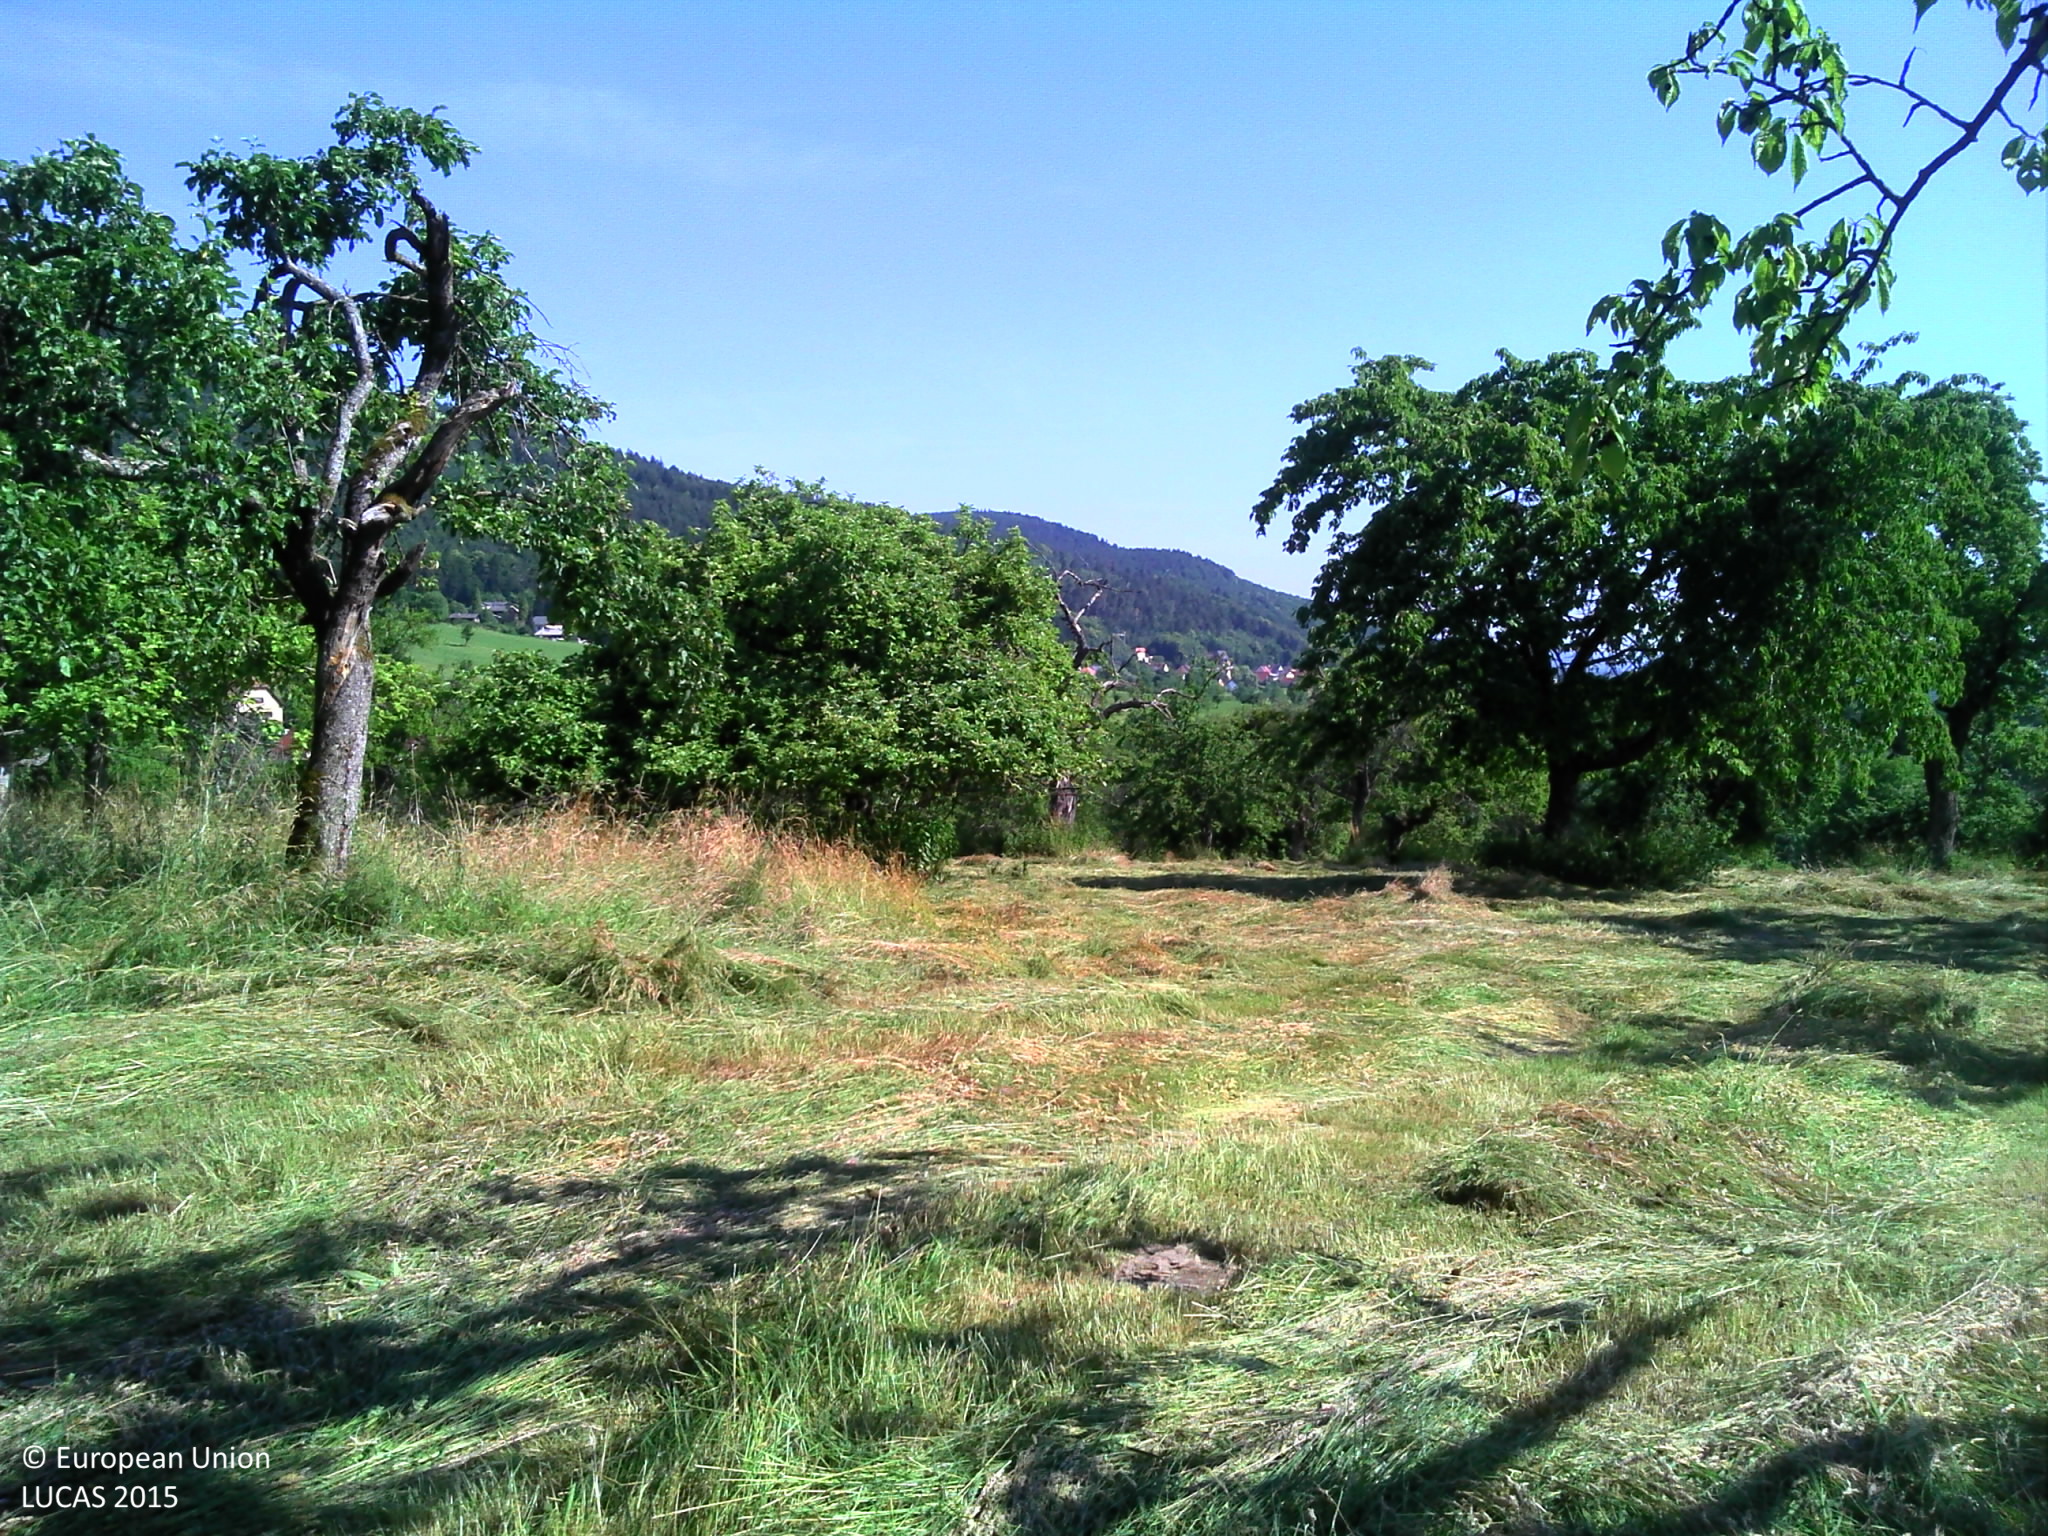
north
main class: Cropland
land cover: Cherry fruit
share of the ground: 50 - 75 %
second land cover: Apple fruit
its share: 10 - 25 %
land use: Agriculture (excluding fallow land and kitchen gardens)
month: June
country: FR
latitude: 48.6772
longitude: 7.3252
